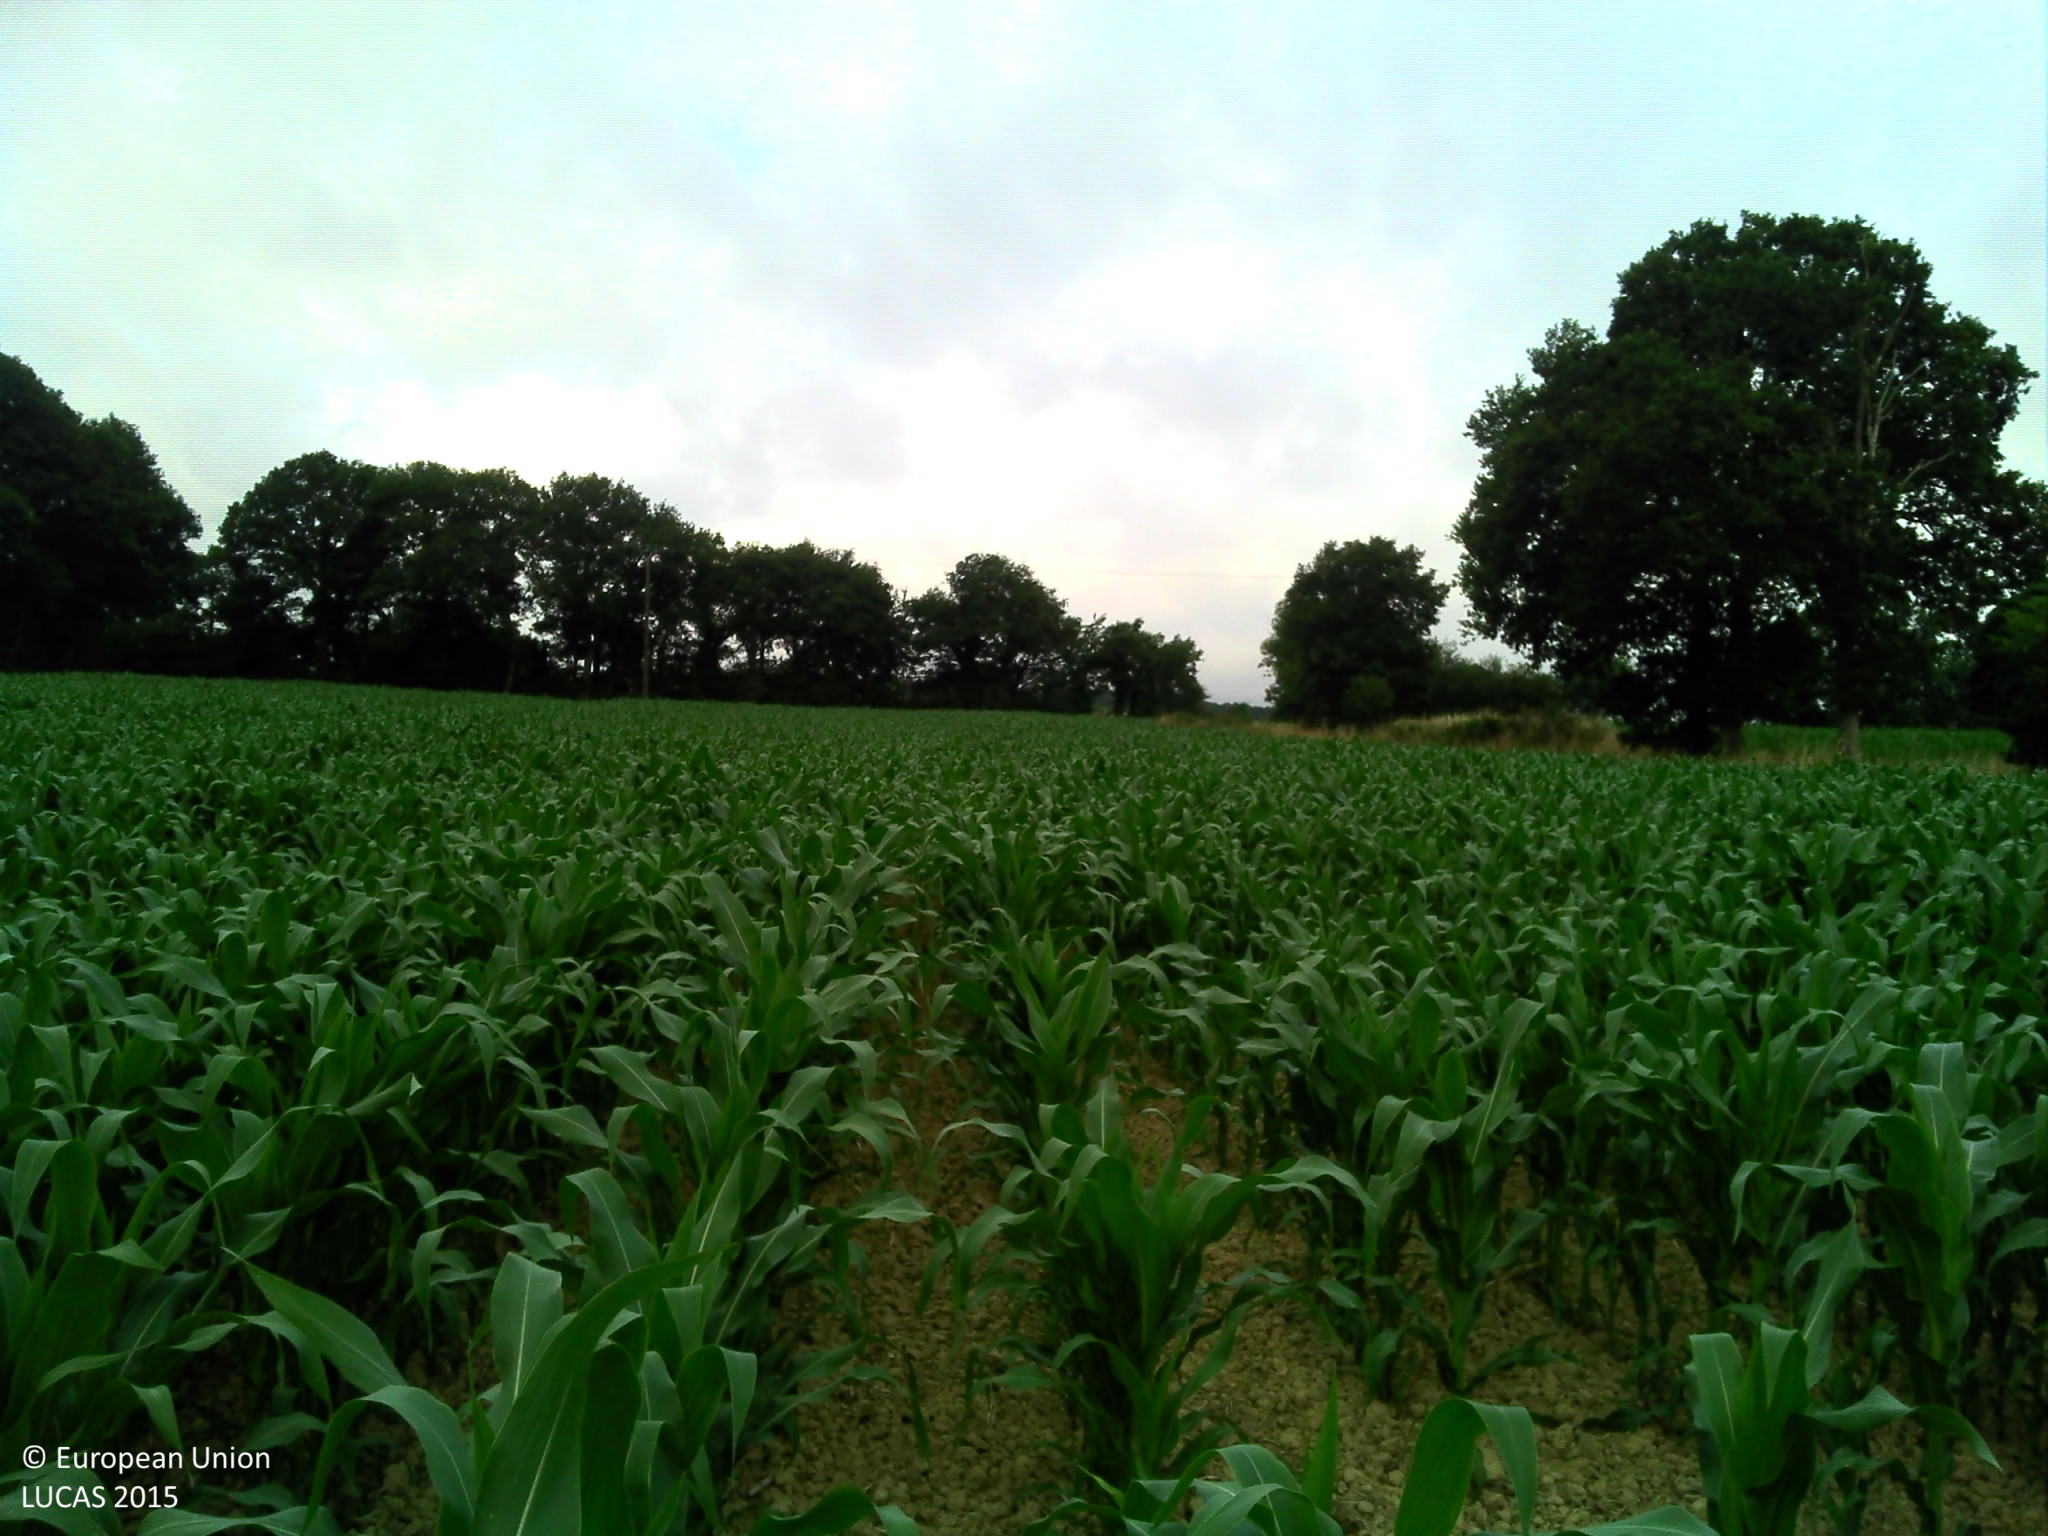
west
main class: Cropland
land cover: Maize
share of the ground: 25 - 50 %
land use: Agriculture (excluding fallow land and kitchen gardens)
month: July
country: FR
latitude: 47.8465
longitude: -1.4153
